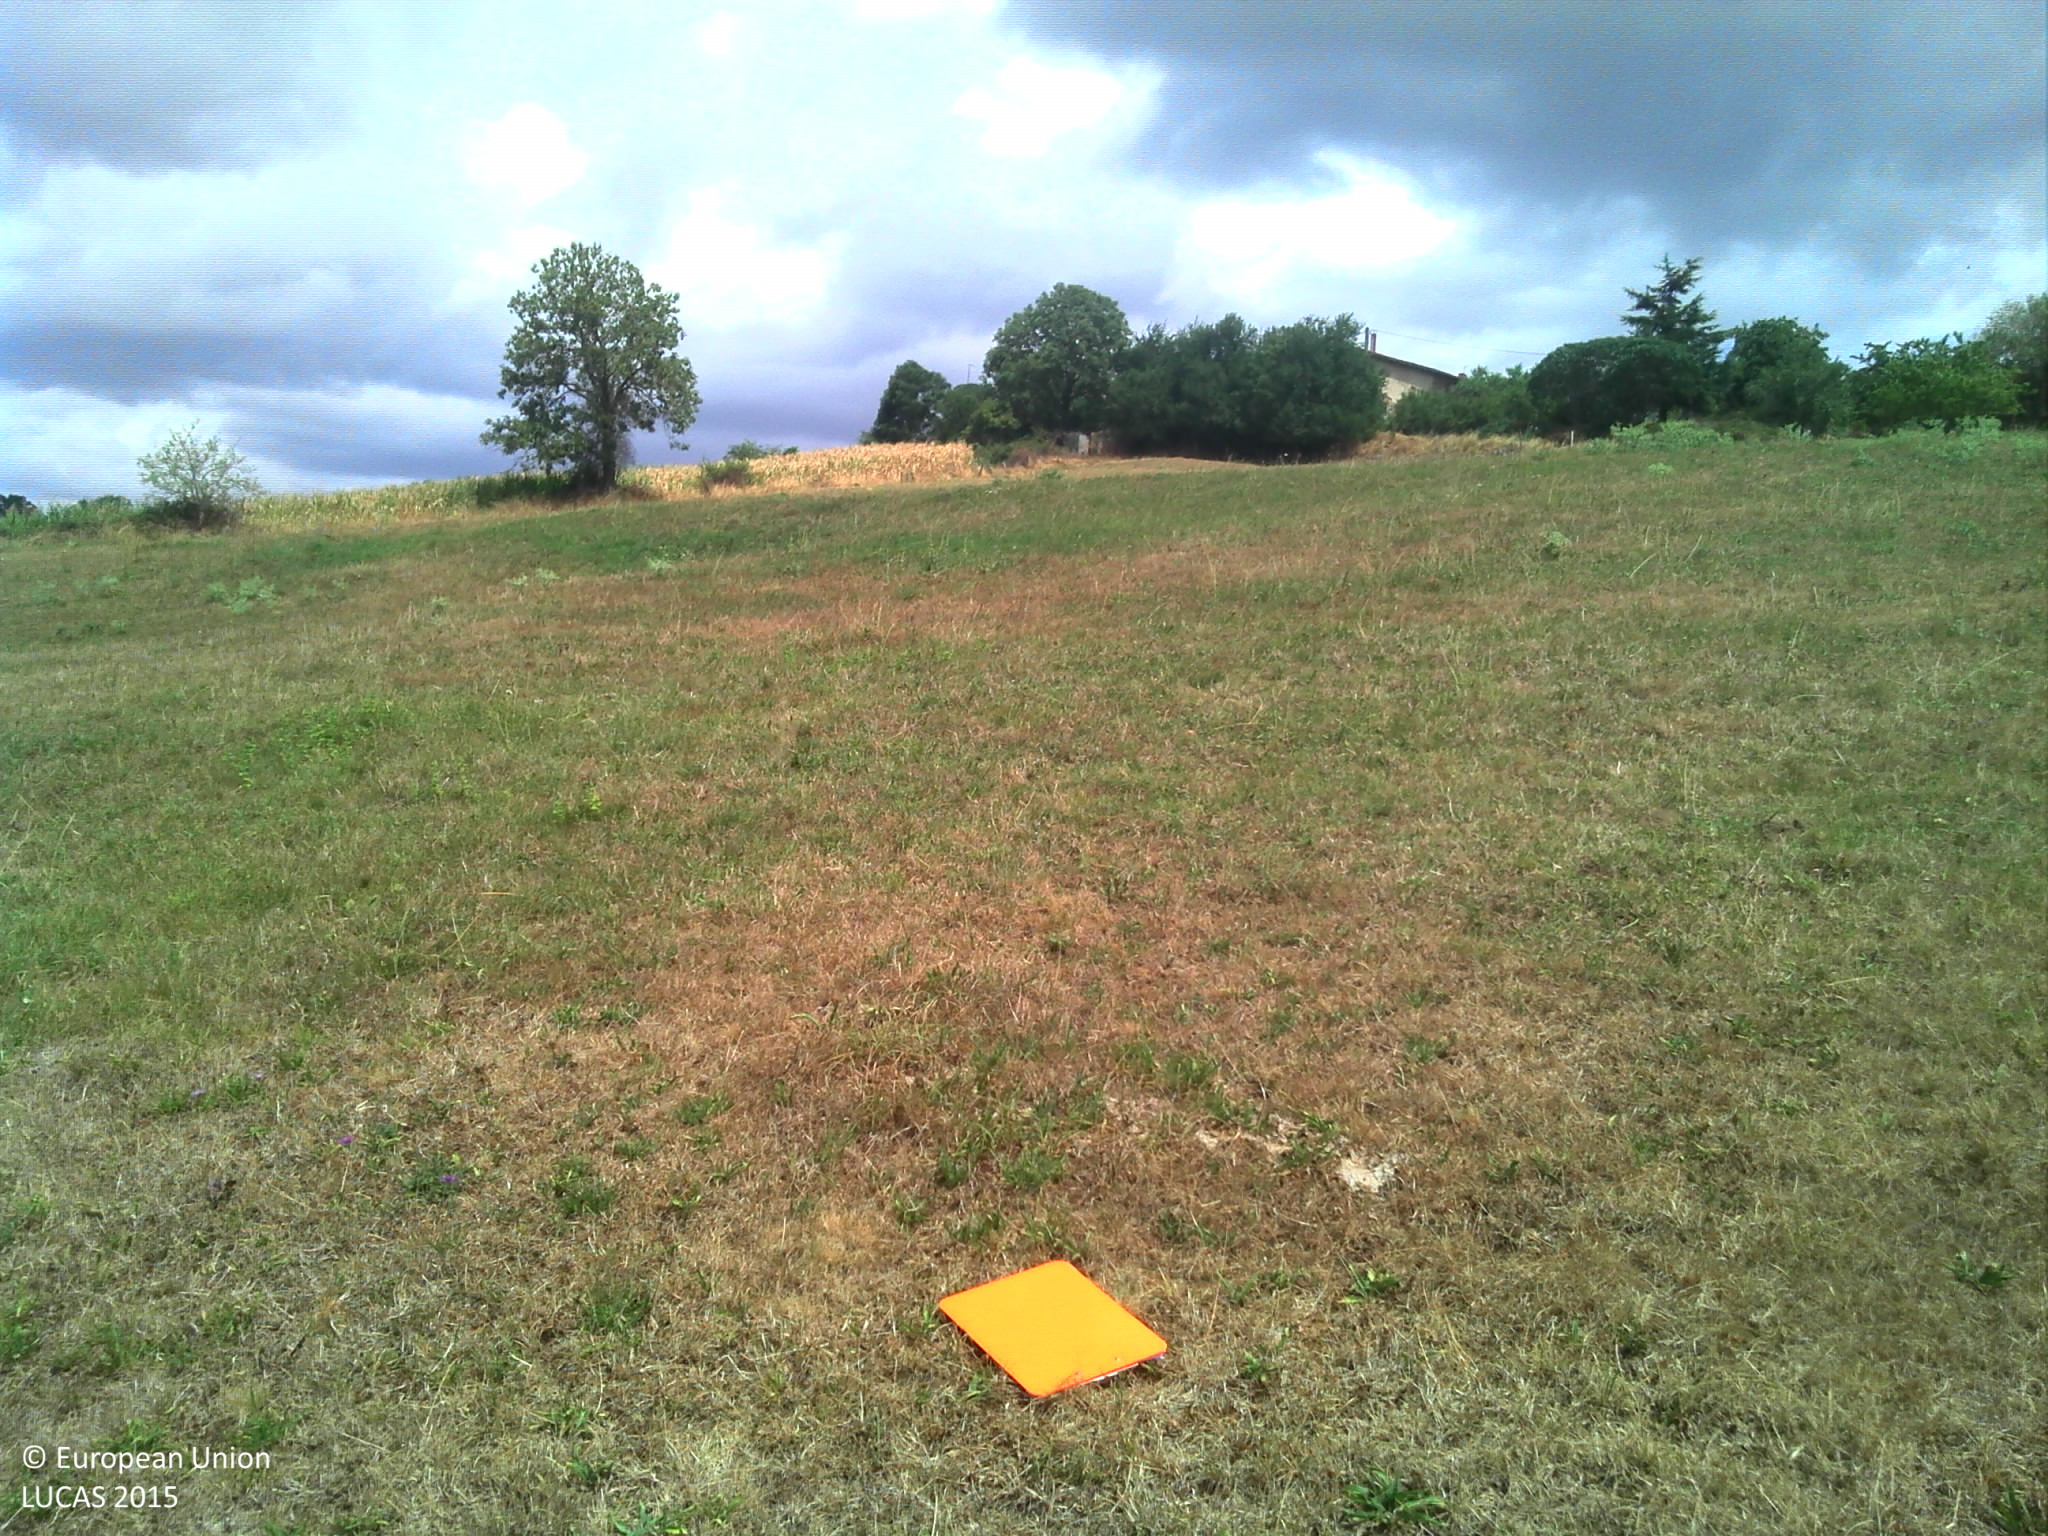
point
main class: Grassland
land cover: Grassland without tree/shrub cover
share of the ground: > 75 %
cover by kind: herbaceous plants 100 %
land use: Agriculture (excluding fallow land and kitchen gardens)
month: July
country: FR
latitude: 45.7398
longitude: 4.4895
